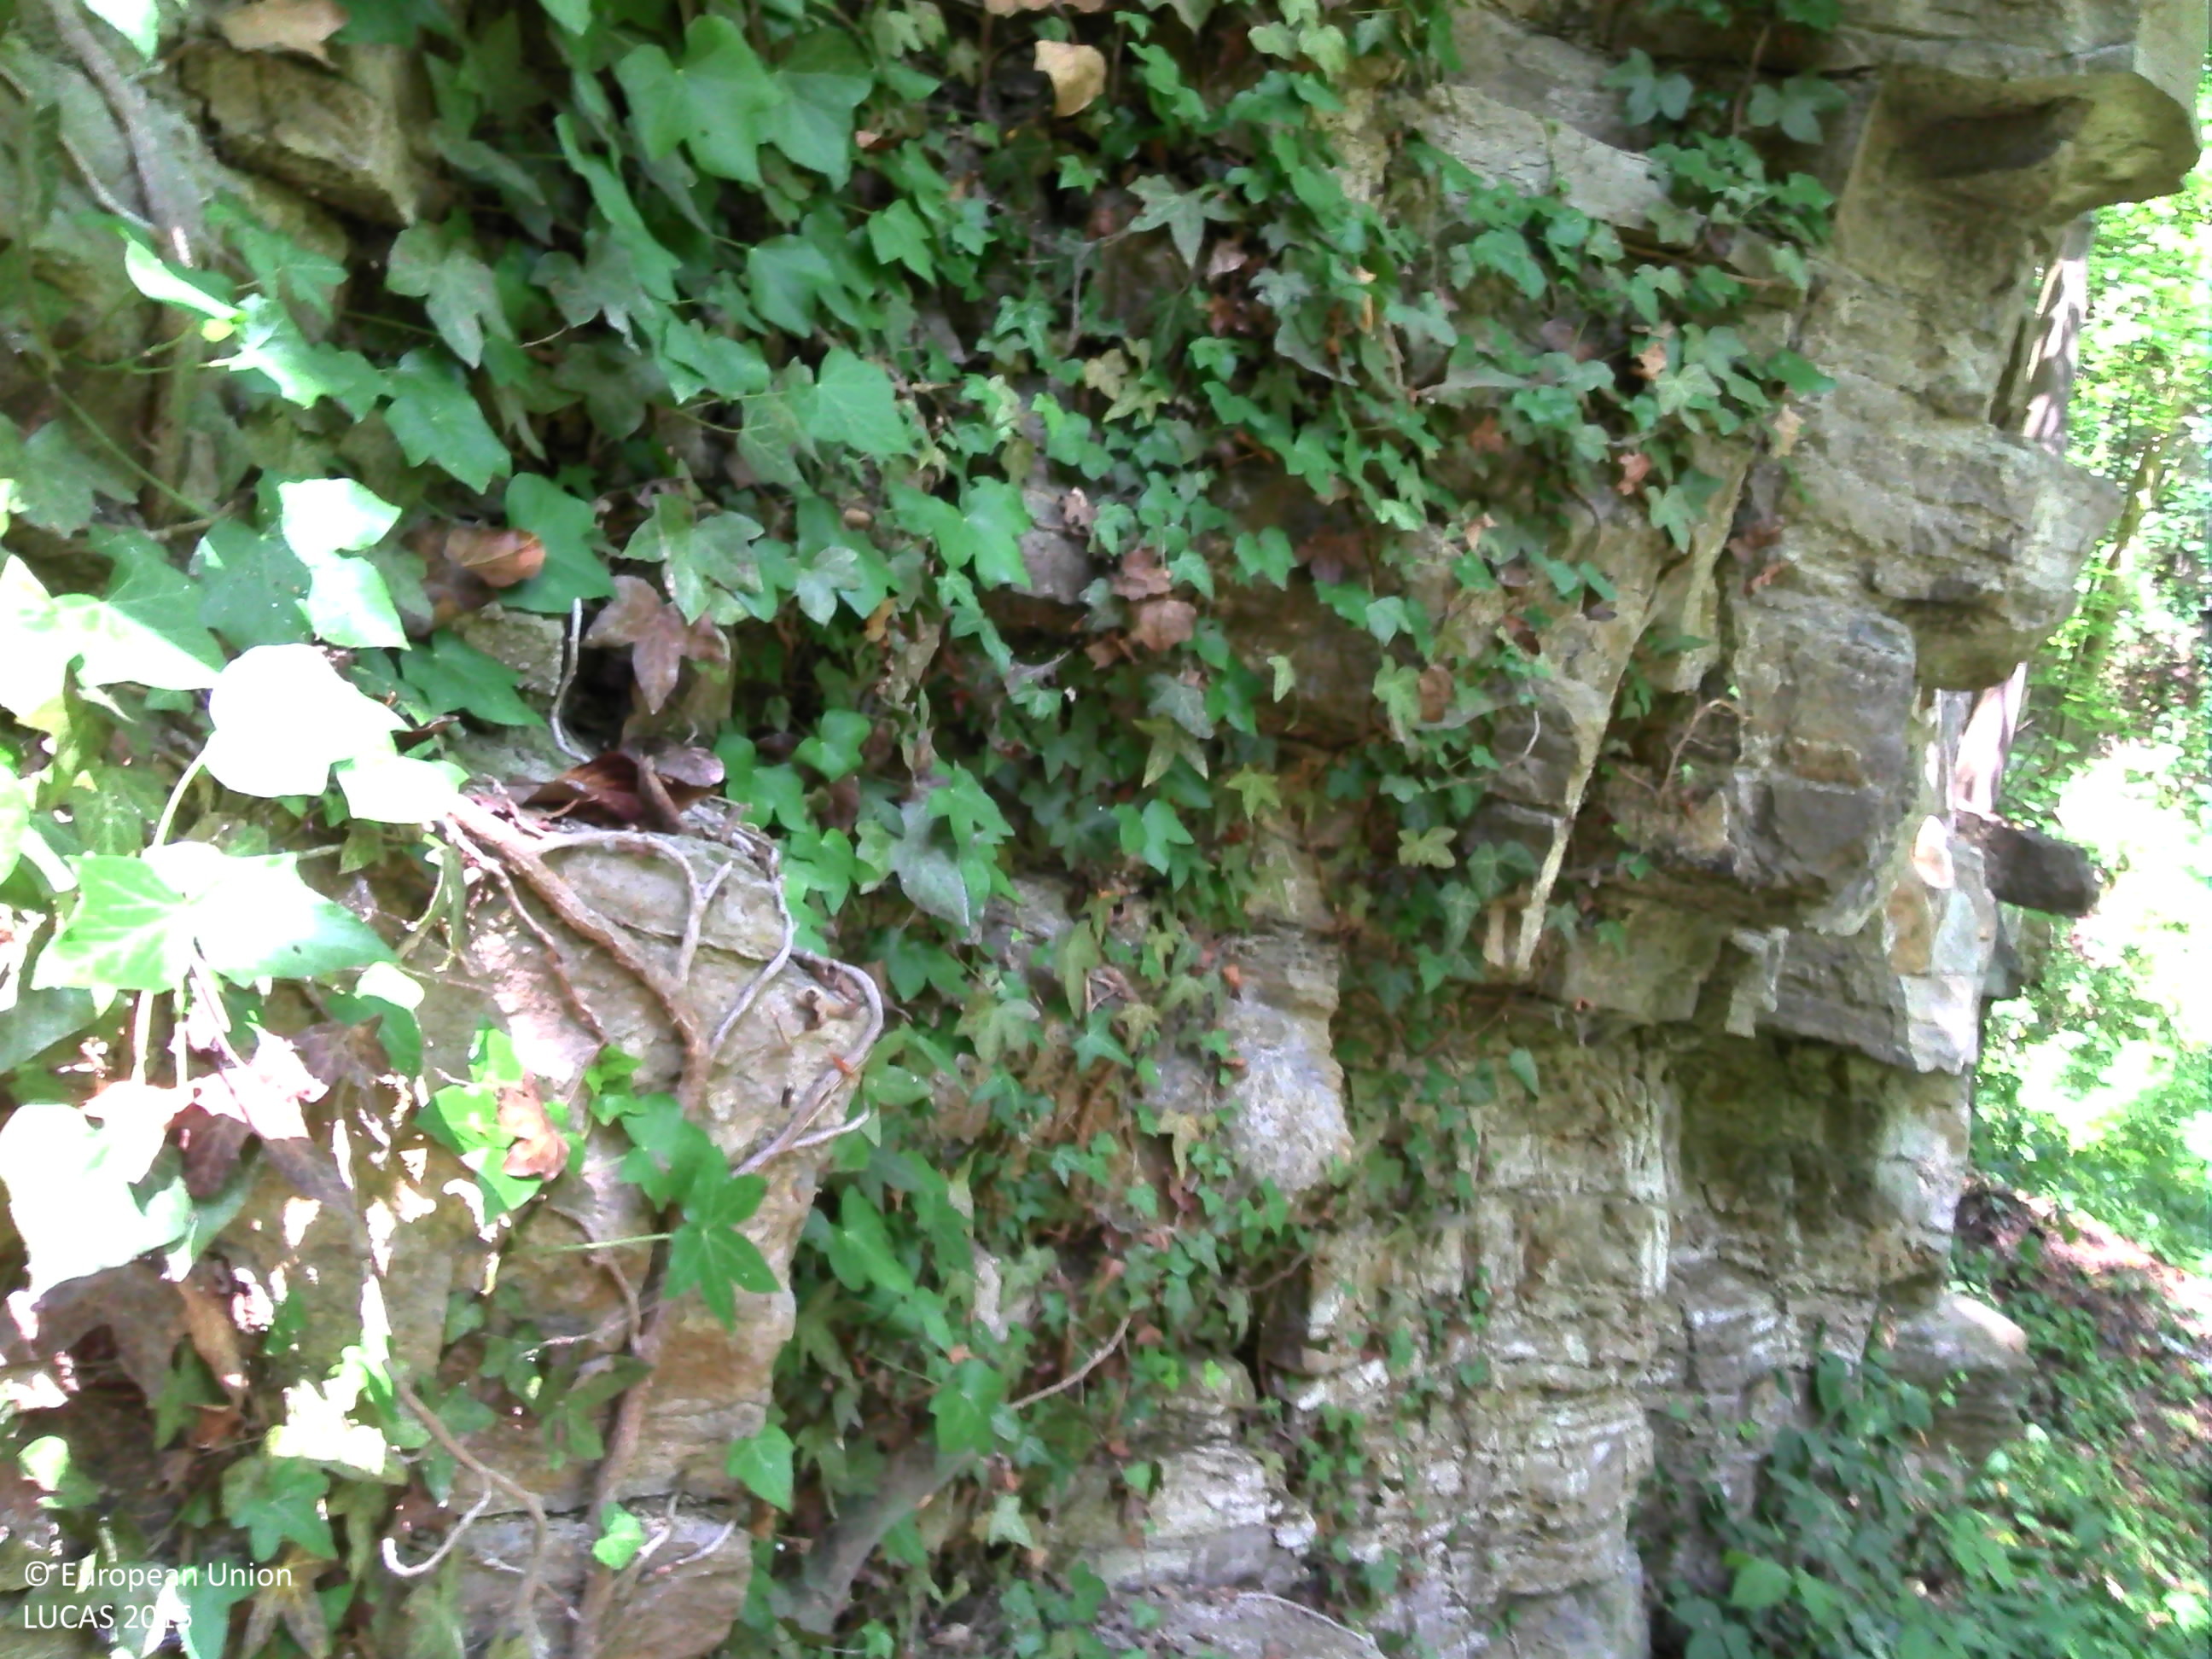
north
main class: Woodland
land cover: Broadleaved woodland
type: mesophytic deciduous forest
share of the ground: > 75 %
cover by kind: broadleaved forest trees 90 %, herbaceous plants 10 %
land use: Forestry
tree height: > 5 m
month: July
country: BE
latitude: 50.5711
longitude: 5.6921
